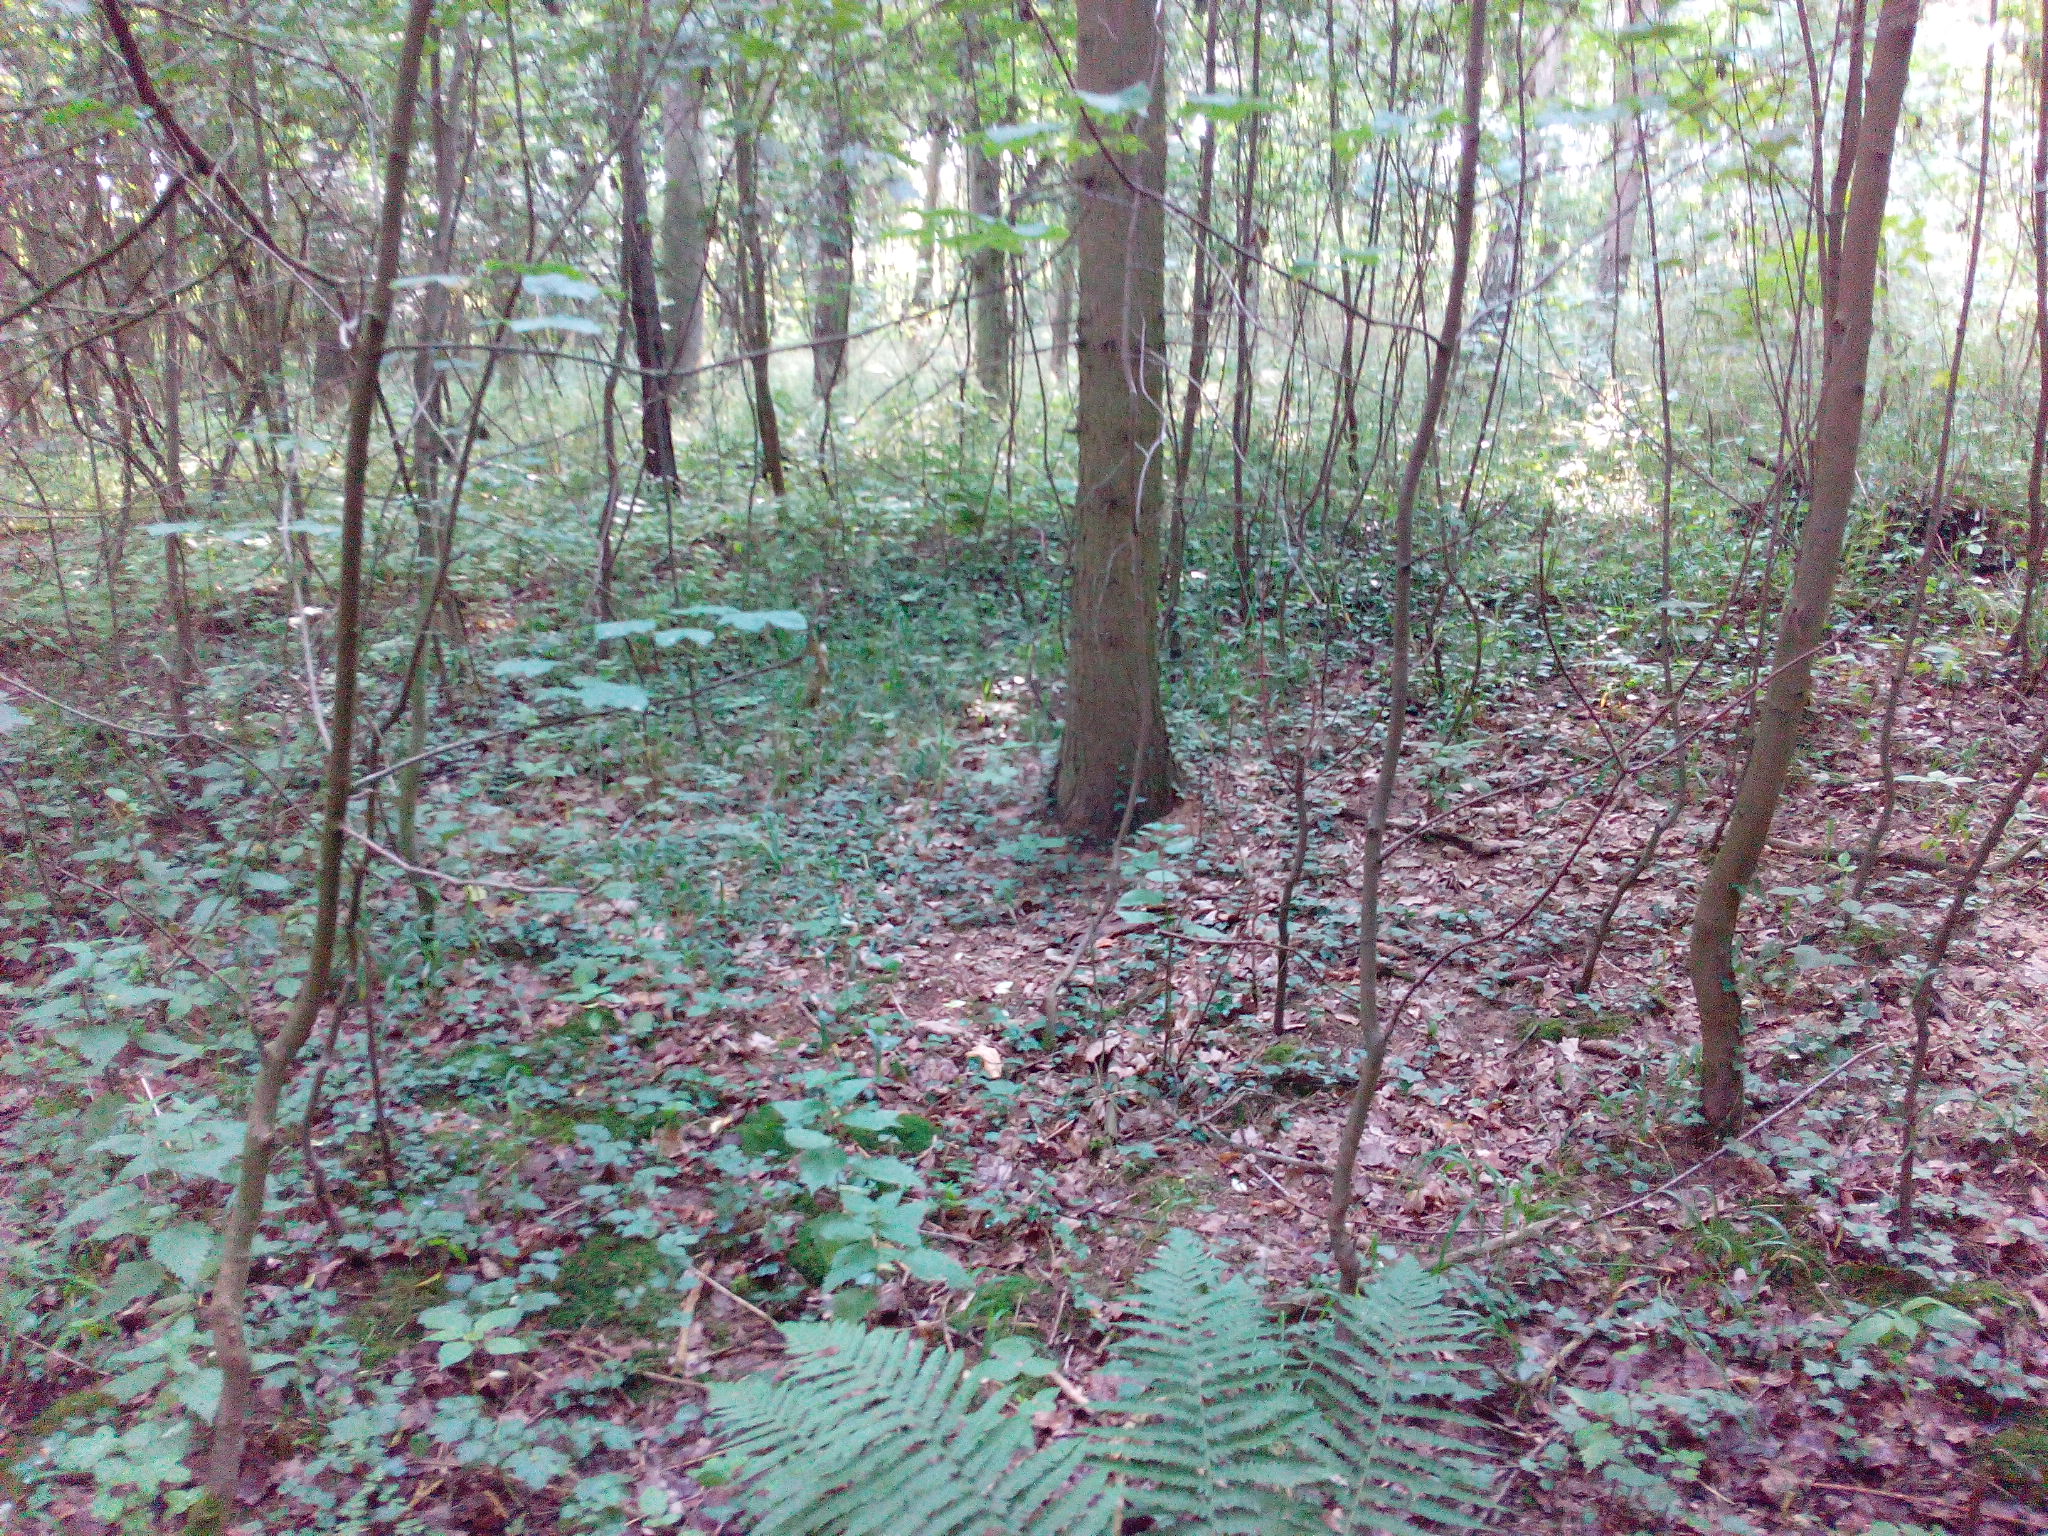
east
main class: Woodland
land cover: Other mixed woodland
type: hemiboreal forest and nemoral coniferous forest and mixed broadleaved-coniferous forest
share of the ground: > 75 %
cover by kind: broadleaved forest trees 50 %, coniferous forest trees 40 %, shrubs 5 %, herbaceous plants 5 %
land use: Forestry
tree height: > 5 m
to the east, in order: Other mixed woodland; Grassland without tree/shrub cover; Barley
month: July
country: DE
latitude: 53.1860
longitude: 14.1760
